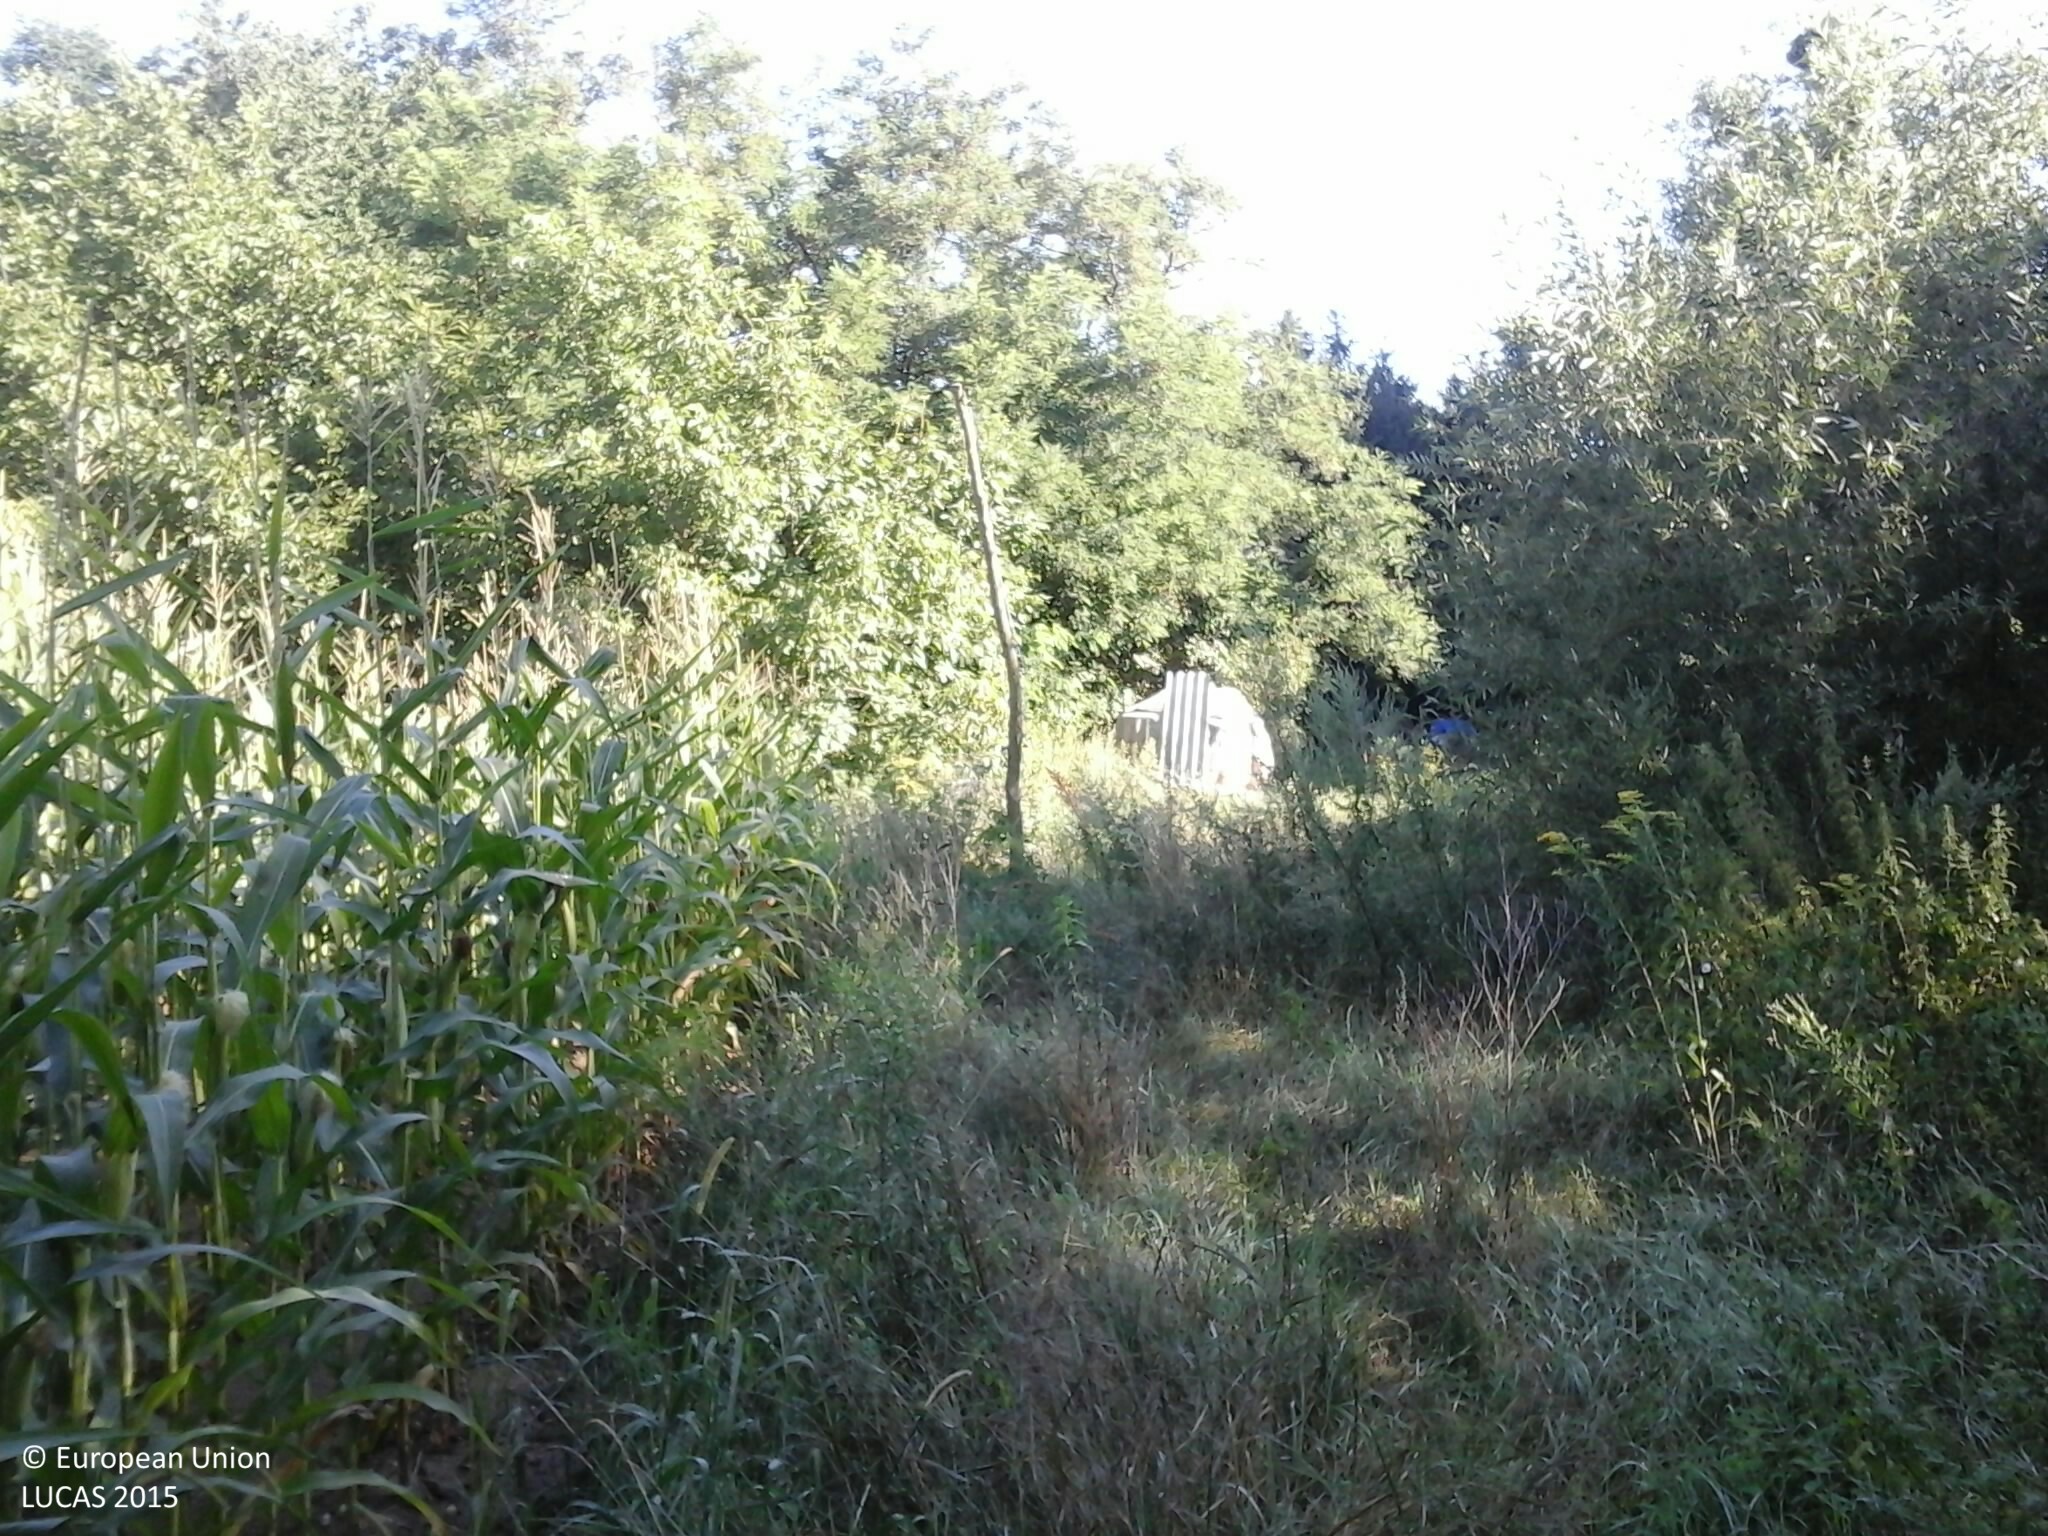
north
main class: Cropland
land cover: Maize
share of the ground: > 75 %
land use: Agriculture (excluding fallow land and kitchen gardens)
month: August
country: HU
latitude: 46.9579
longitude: 16.6390
